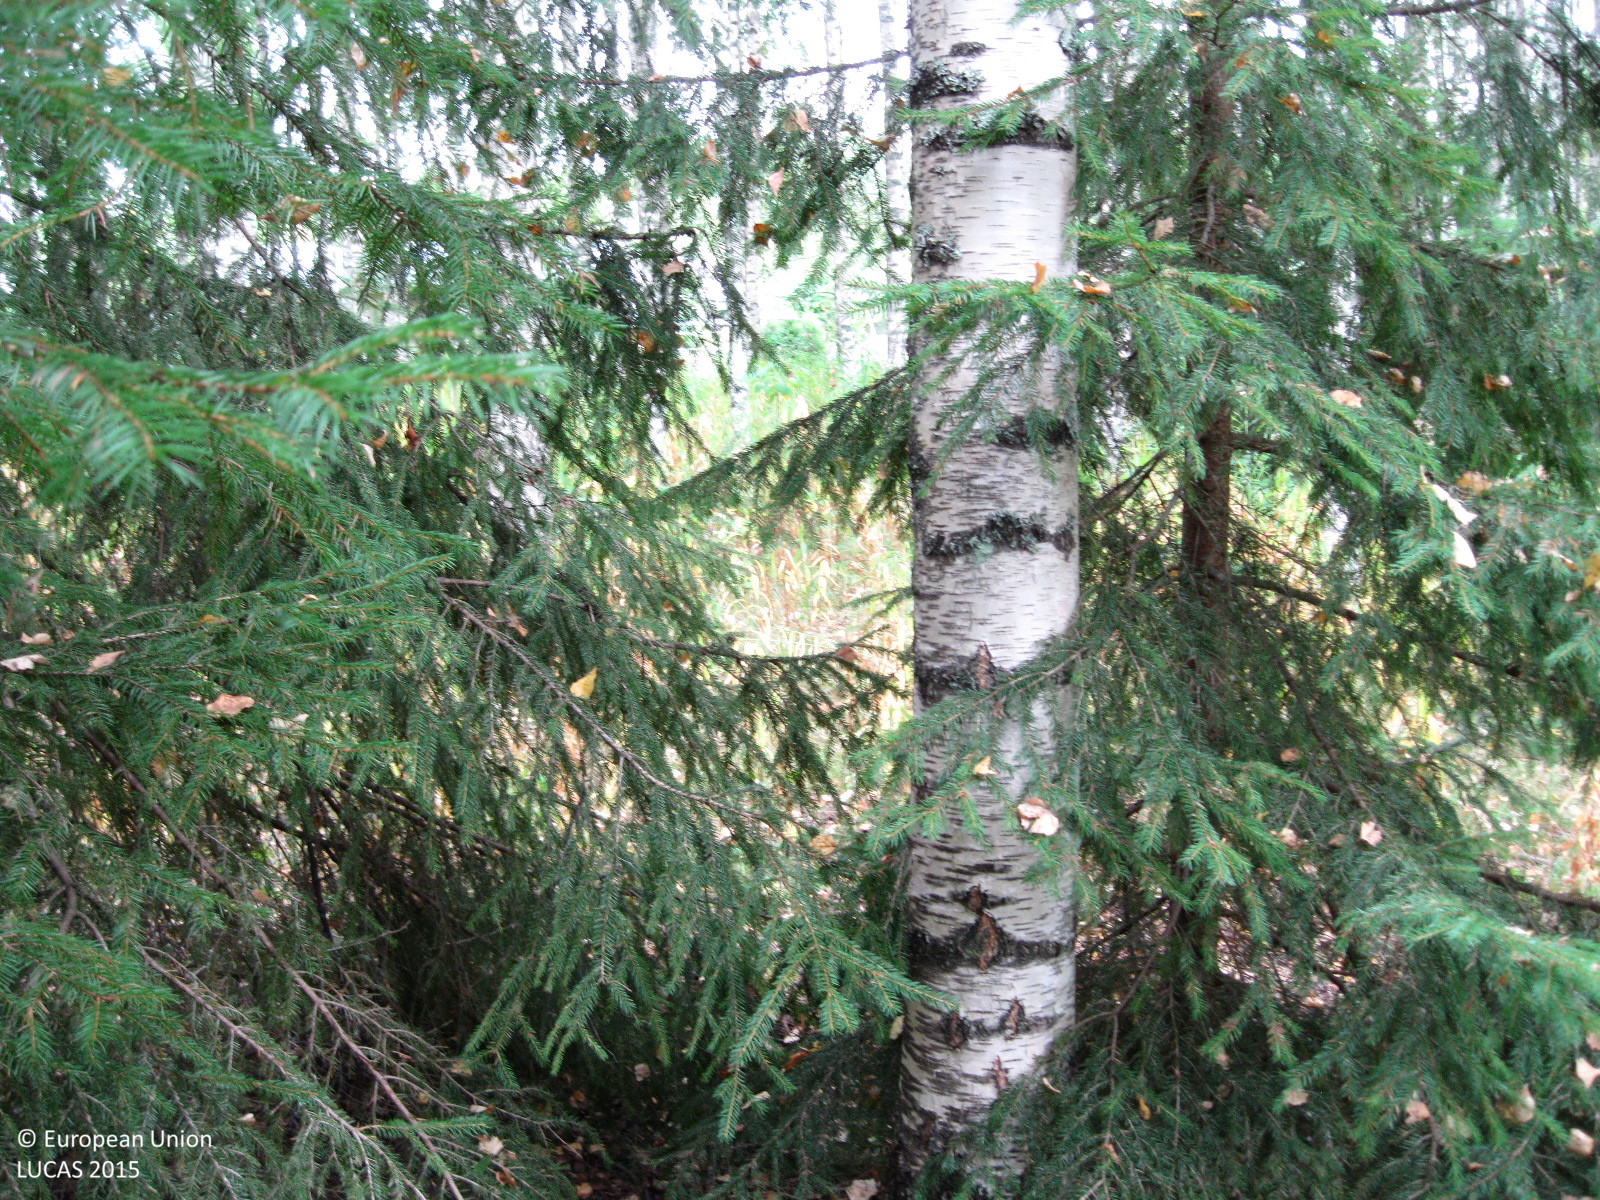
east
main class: Woodland
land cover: Broadleaved woodland
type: boreal forest
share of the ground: 50 - 75 %
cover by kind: broadleaved forest trees 55 %, herbaceous plants 25 %, coniferous forest trees 10 %, lichens and mosses 10 %
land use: Residential
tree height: > 5 m
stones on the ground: < 10 %
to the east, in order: Broadleaved woodland; Artificial constructions in urban areas; Spontaneously vegetated surfaces; Broadleaved woodland; Spontaneously vegetated surfaces; Broadleaved woodland; Spontaneously vegetated surfaces; Shrubland without tree cover; Spruce dominated mixed woodland; Spontaneously vegetated surfaces; Paved roads, cycling and walking lanes; Other mixed woodland; Spontaneously vegetated surfaces
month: August
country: FI
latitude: 61.1597
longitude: 25.6454
